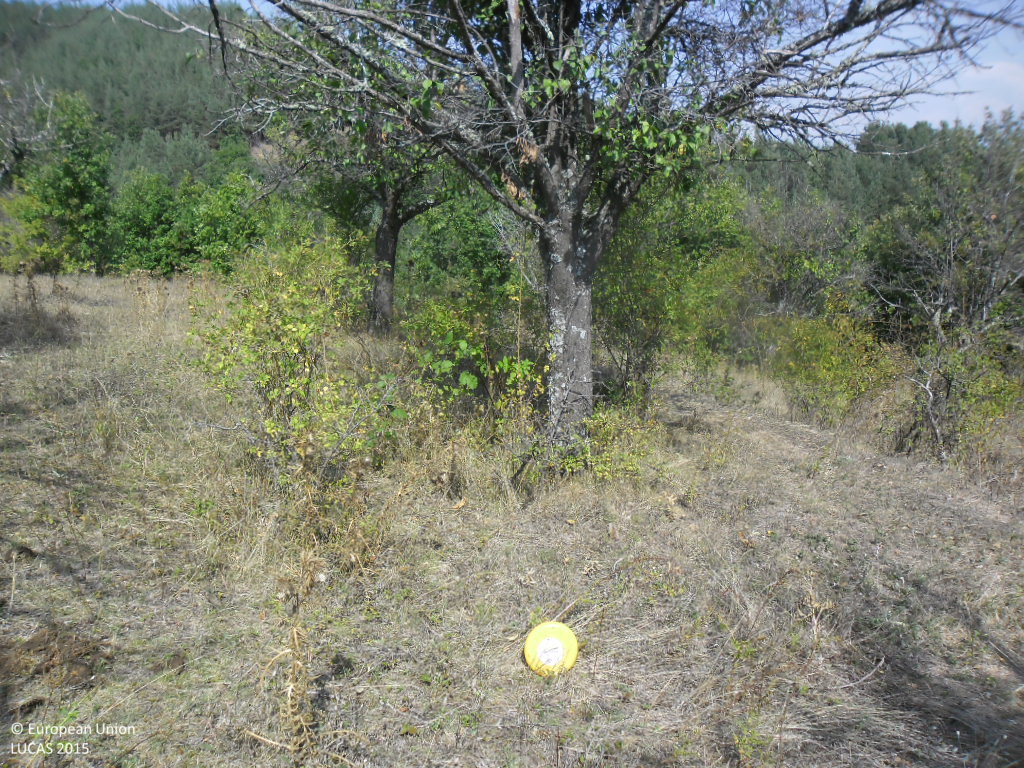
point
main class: Cropland
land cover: Other fruit trees and berries
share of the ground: 25 - 50 %
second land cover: Grassland without tree/shrub cover
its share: > 75 %
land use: Agriculture (excluding fallow land and kitchen gardens)
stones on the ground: < 10 %
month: September
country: BG
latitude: 41.8884
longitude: 22.9770
